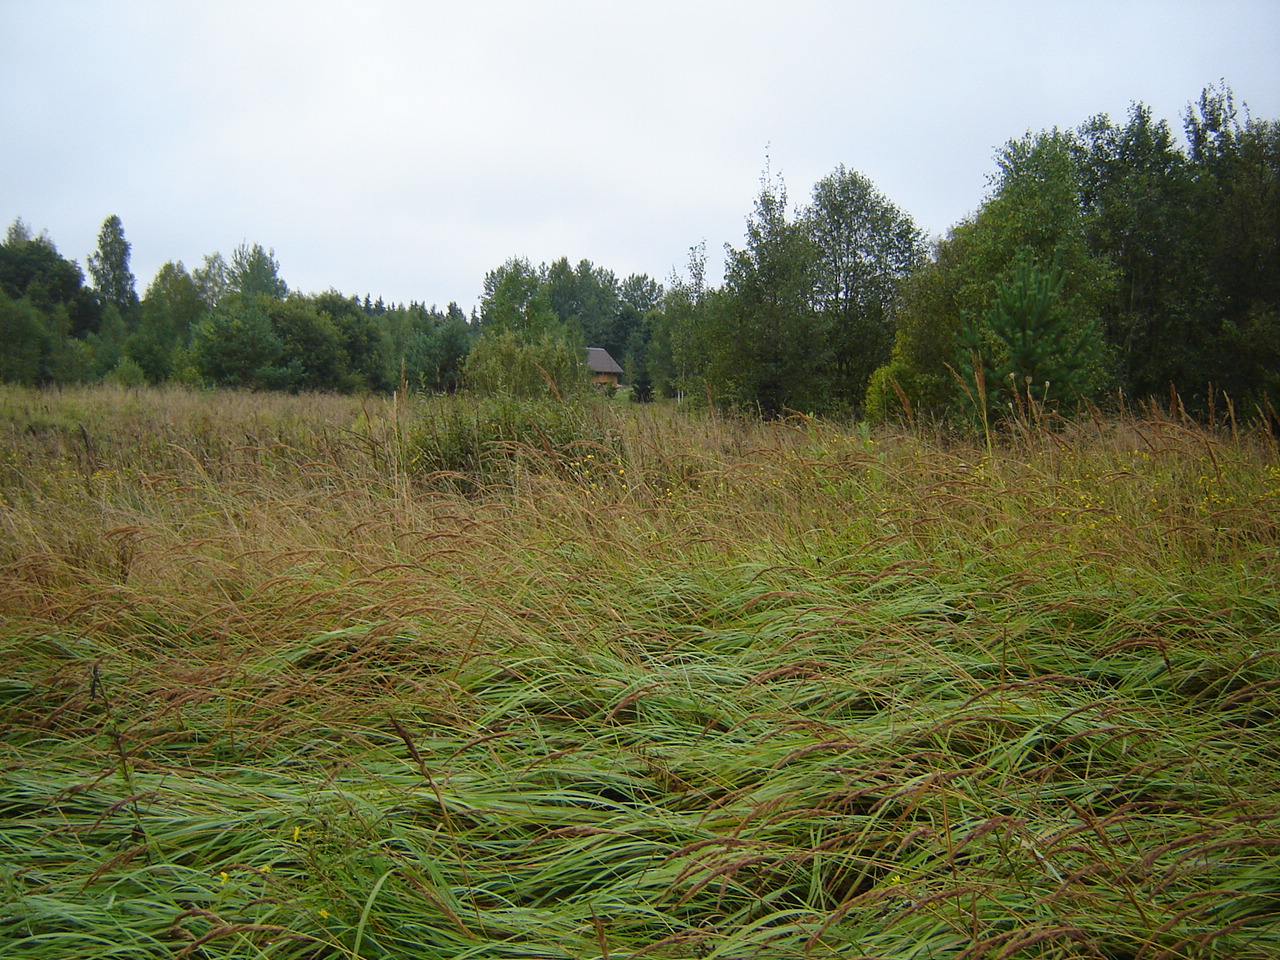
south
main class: Woodland
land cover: Pine dominated mixed woodland
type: hemiboreal forest and nemoral coniferous forest and mixed broadleaved-coniferous forest
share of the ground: 25 - 50 %
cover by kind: herbaceous plants 70 %, broadleaved forest trees 20 %, coniferous forest trees 10 %
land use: Forestry
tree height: < 5 m
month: September
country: LT
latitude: 54.8926
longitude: 25.3234
